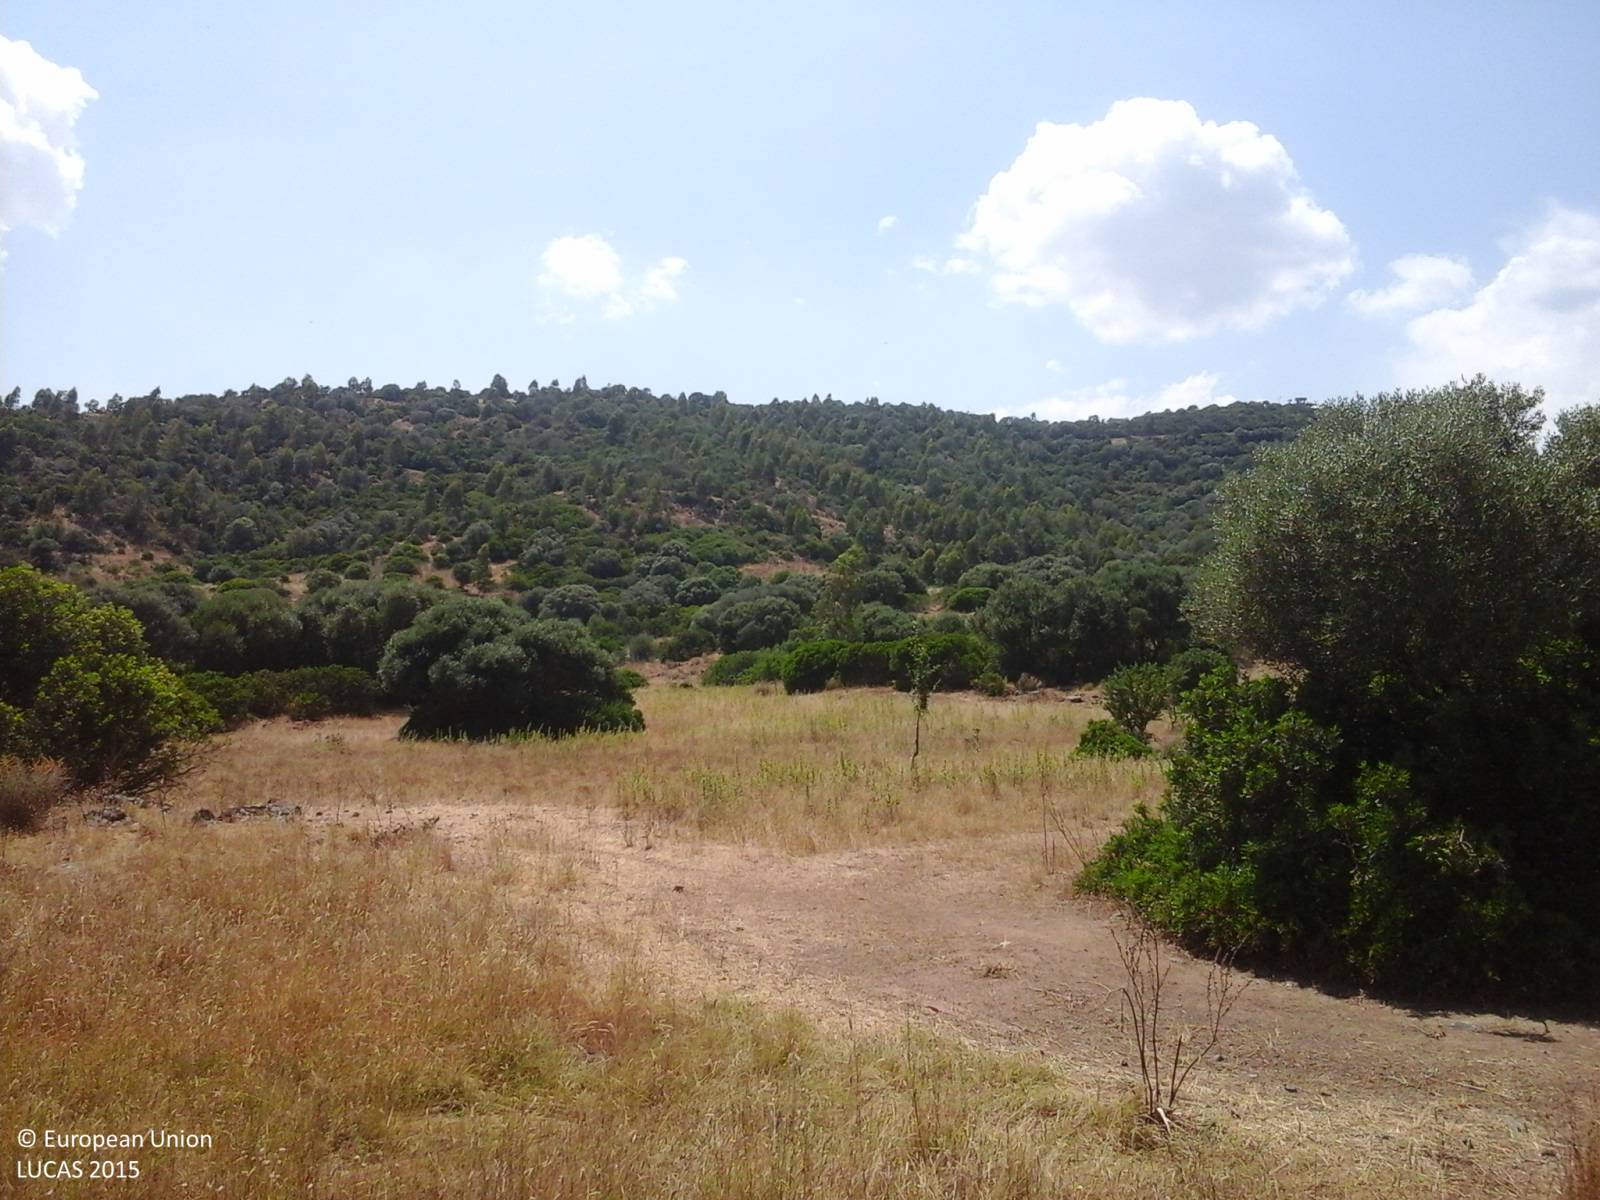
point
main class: Woodland
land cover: Broadleaved woodland
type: broadleaved evergreen forest
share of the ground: > 75 %
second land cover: Grassland without tree/shrub cover
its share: > 75 %
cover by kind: broadleaved forest trees 70 %, shrubs 20 %, herbaceous plants 10 %
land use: Forestry
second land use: Agriculture (excluding fallow land and kitchen gardens)
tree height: > 5 m
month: June
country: IT
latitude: 39.3186
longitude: 8.8356
